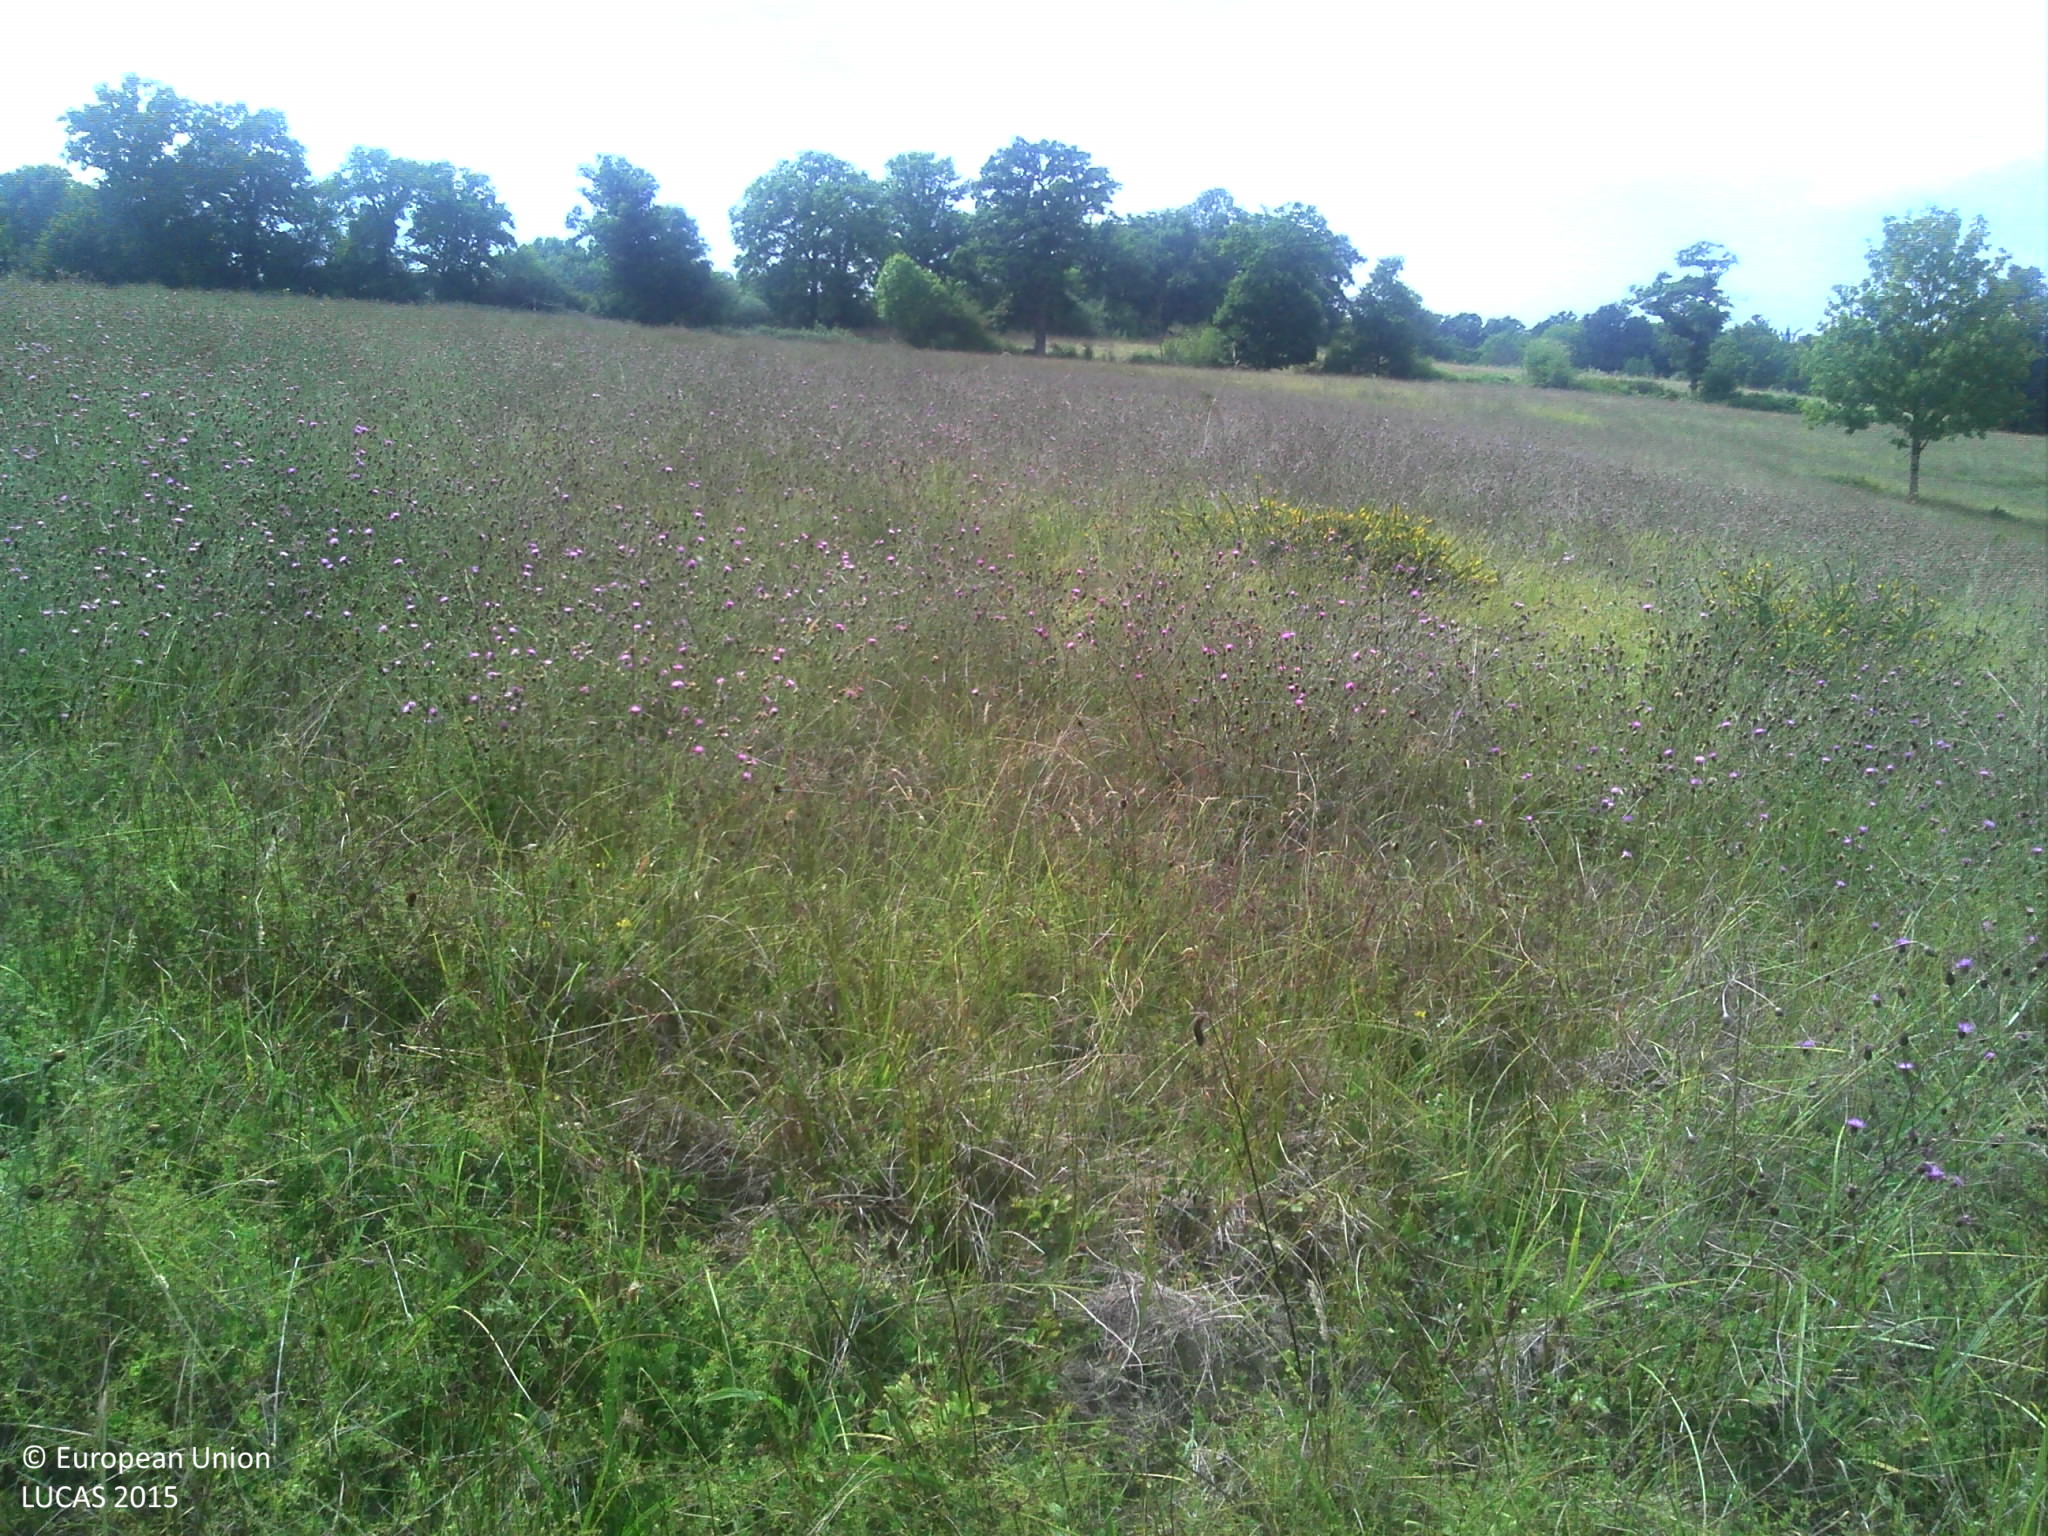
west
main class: Grassland
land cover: Spontaneously vegetated surfaces
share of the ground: > 75 %
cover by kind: herbaceous plants 95 %, shrubs 5 %
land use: Agriculture (excluding fallow land and kitchen gardens)
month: August
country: FR
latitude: 46.0935
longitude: 0.9466
